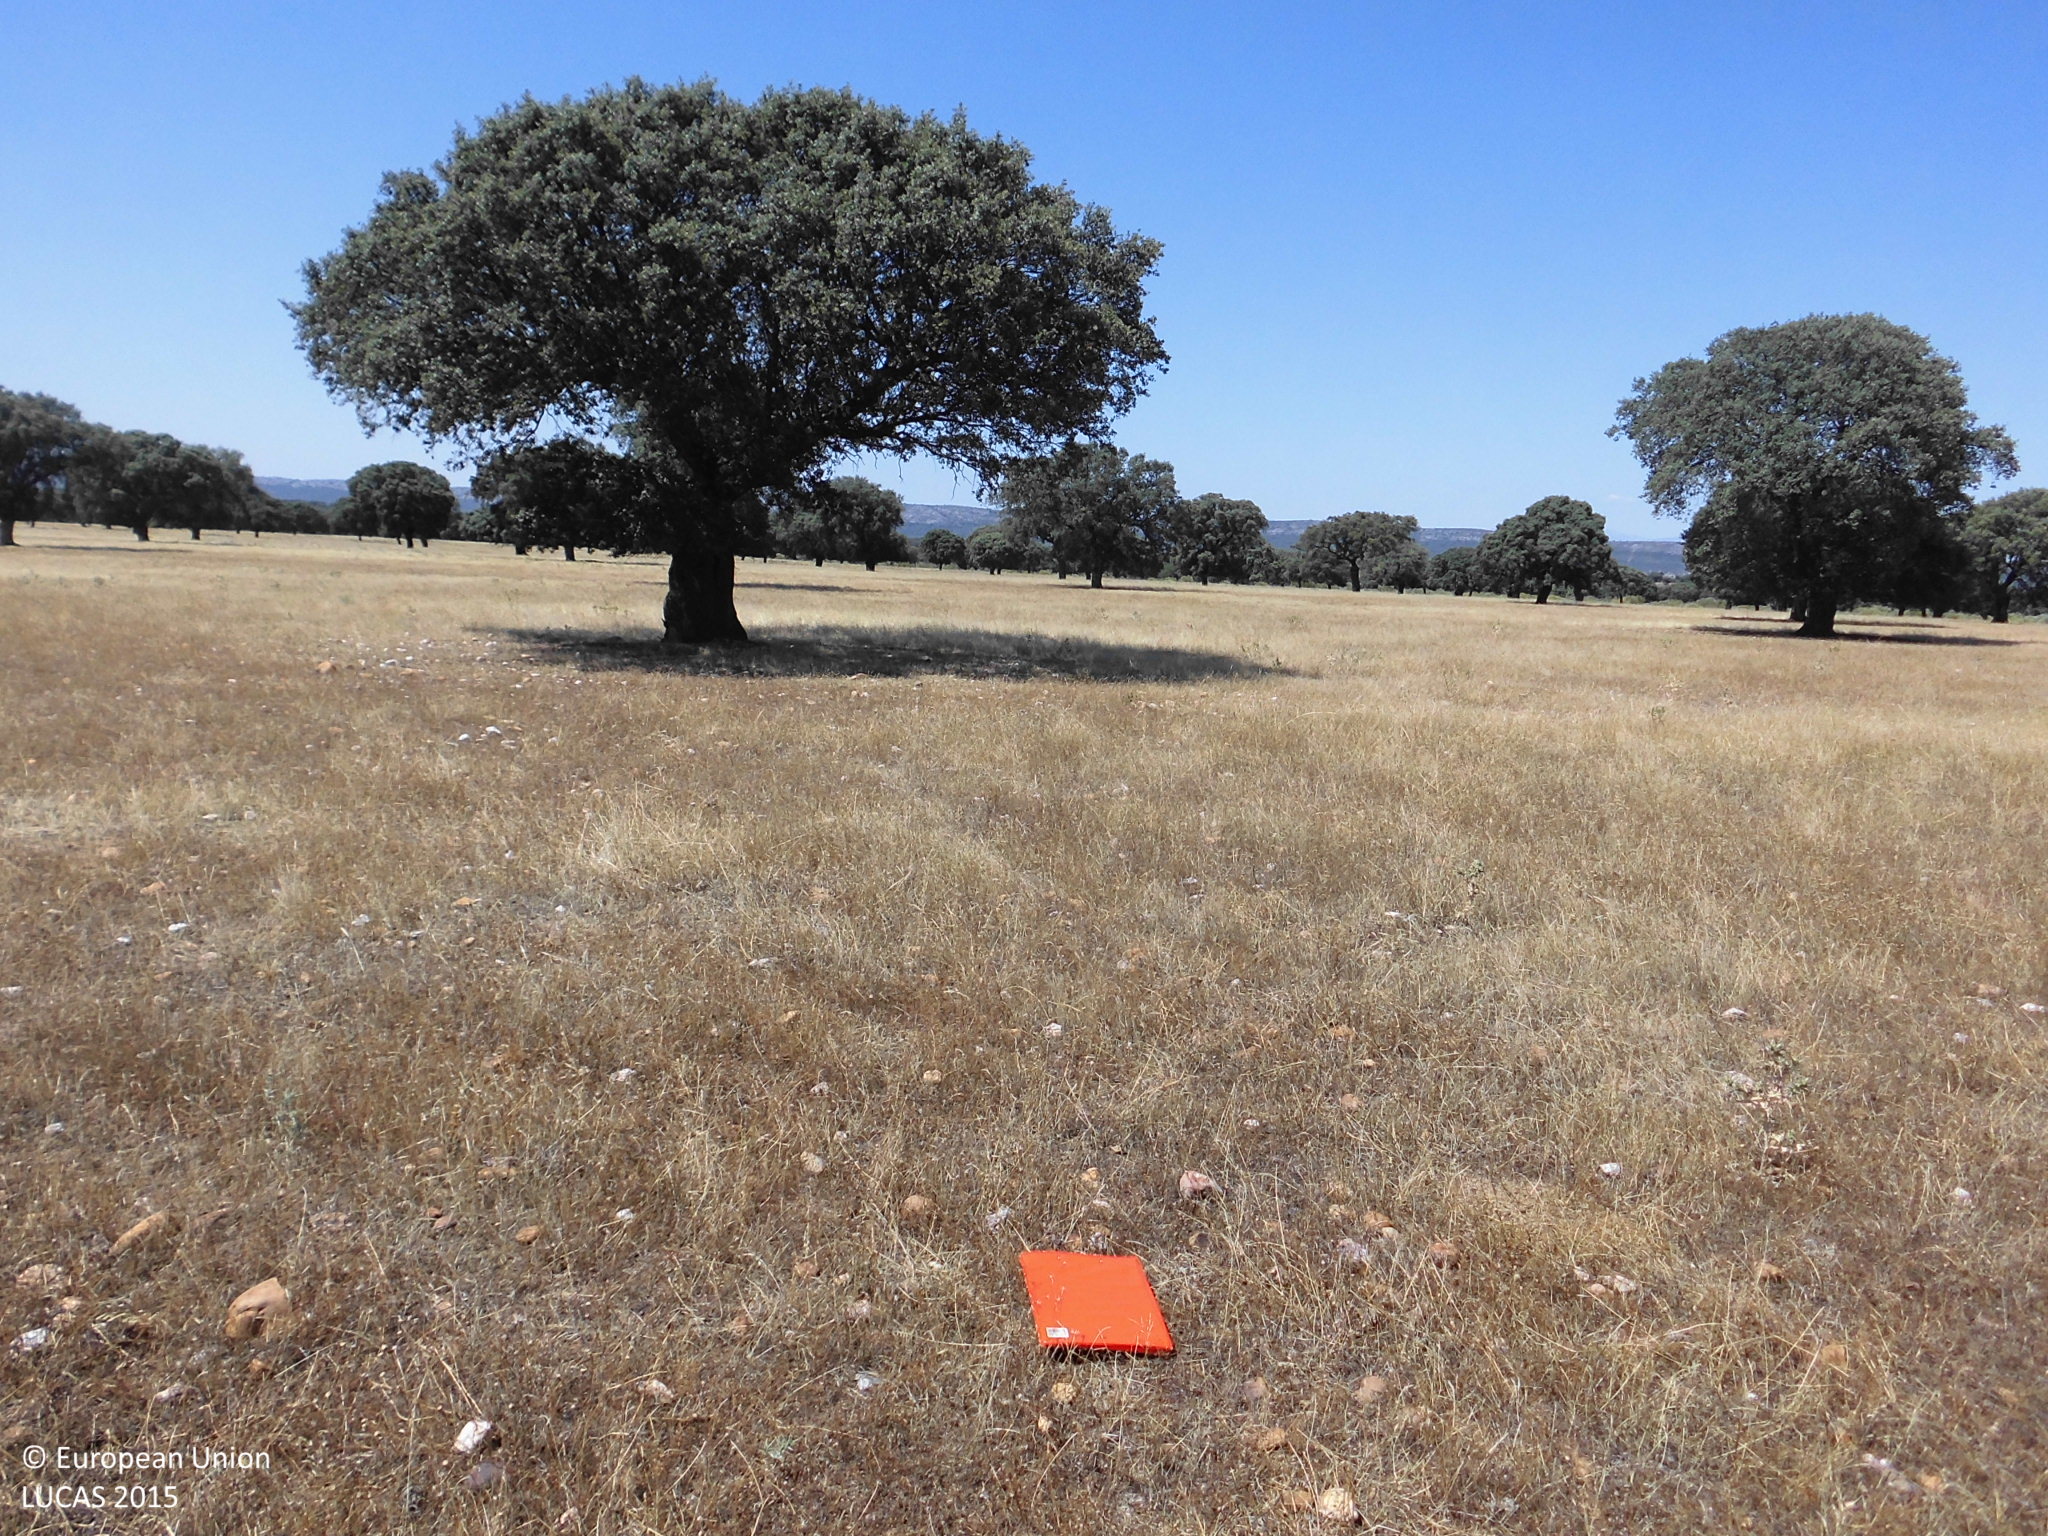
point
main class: Grassland
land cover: Grassland with sparse tree/shrub cover
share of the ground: > 75 %
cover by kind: herbaceous plants 95 %, broadleaved forest trees 5 %
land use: Agriculture (excluding fallow land and kitchen gardens)
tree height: > 5 m
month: June
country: ES
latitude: 39.7410
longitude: -5.9697
